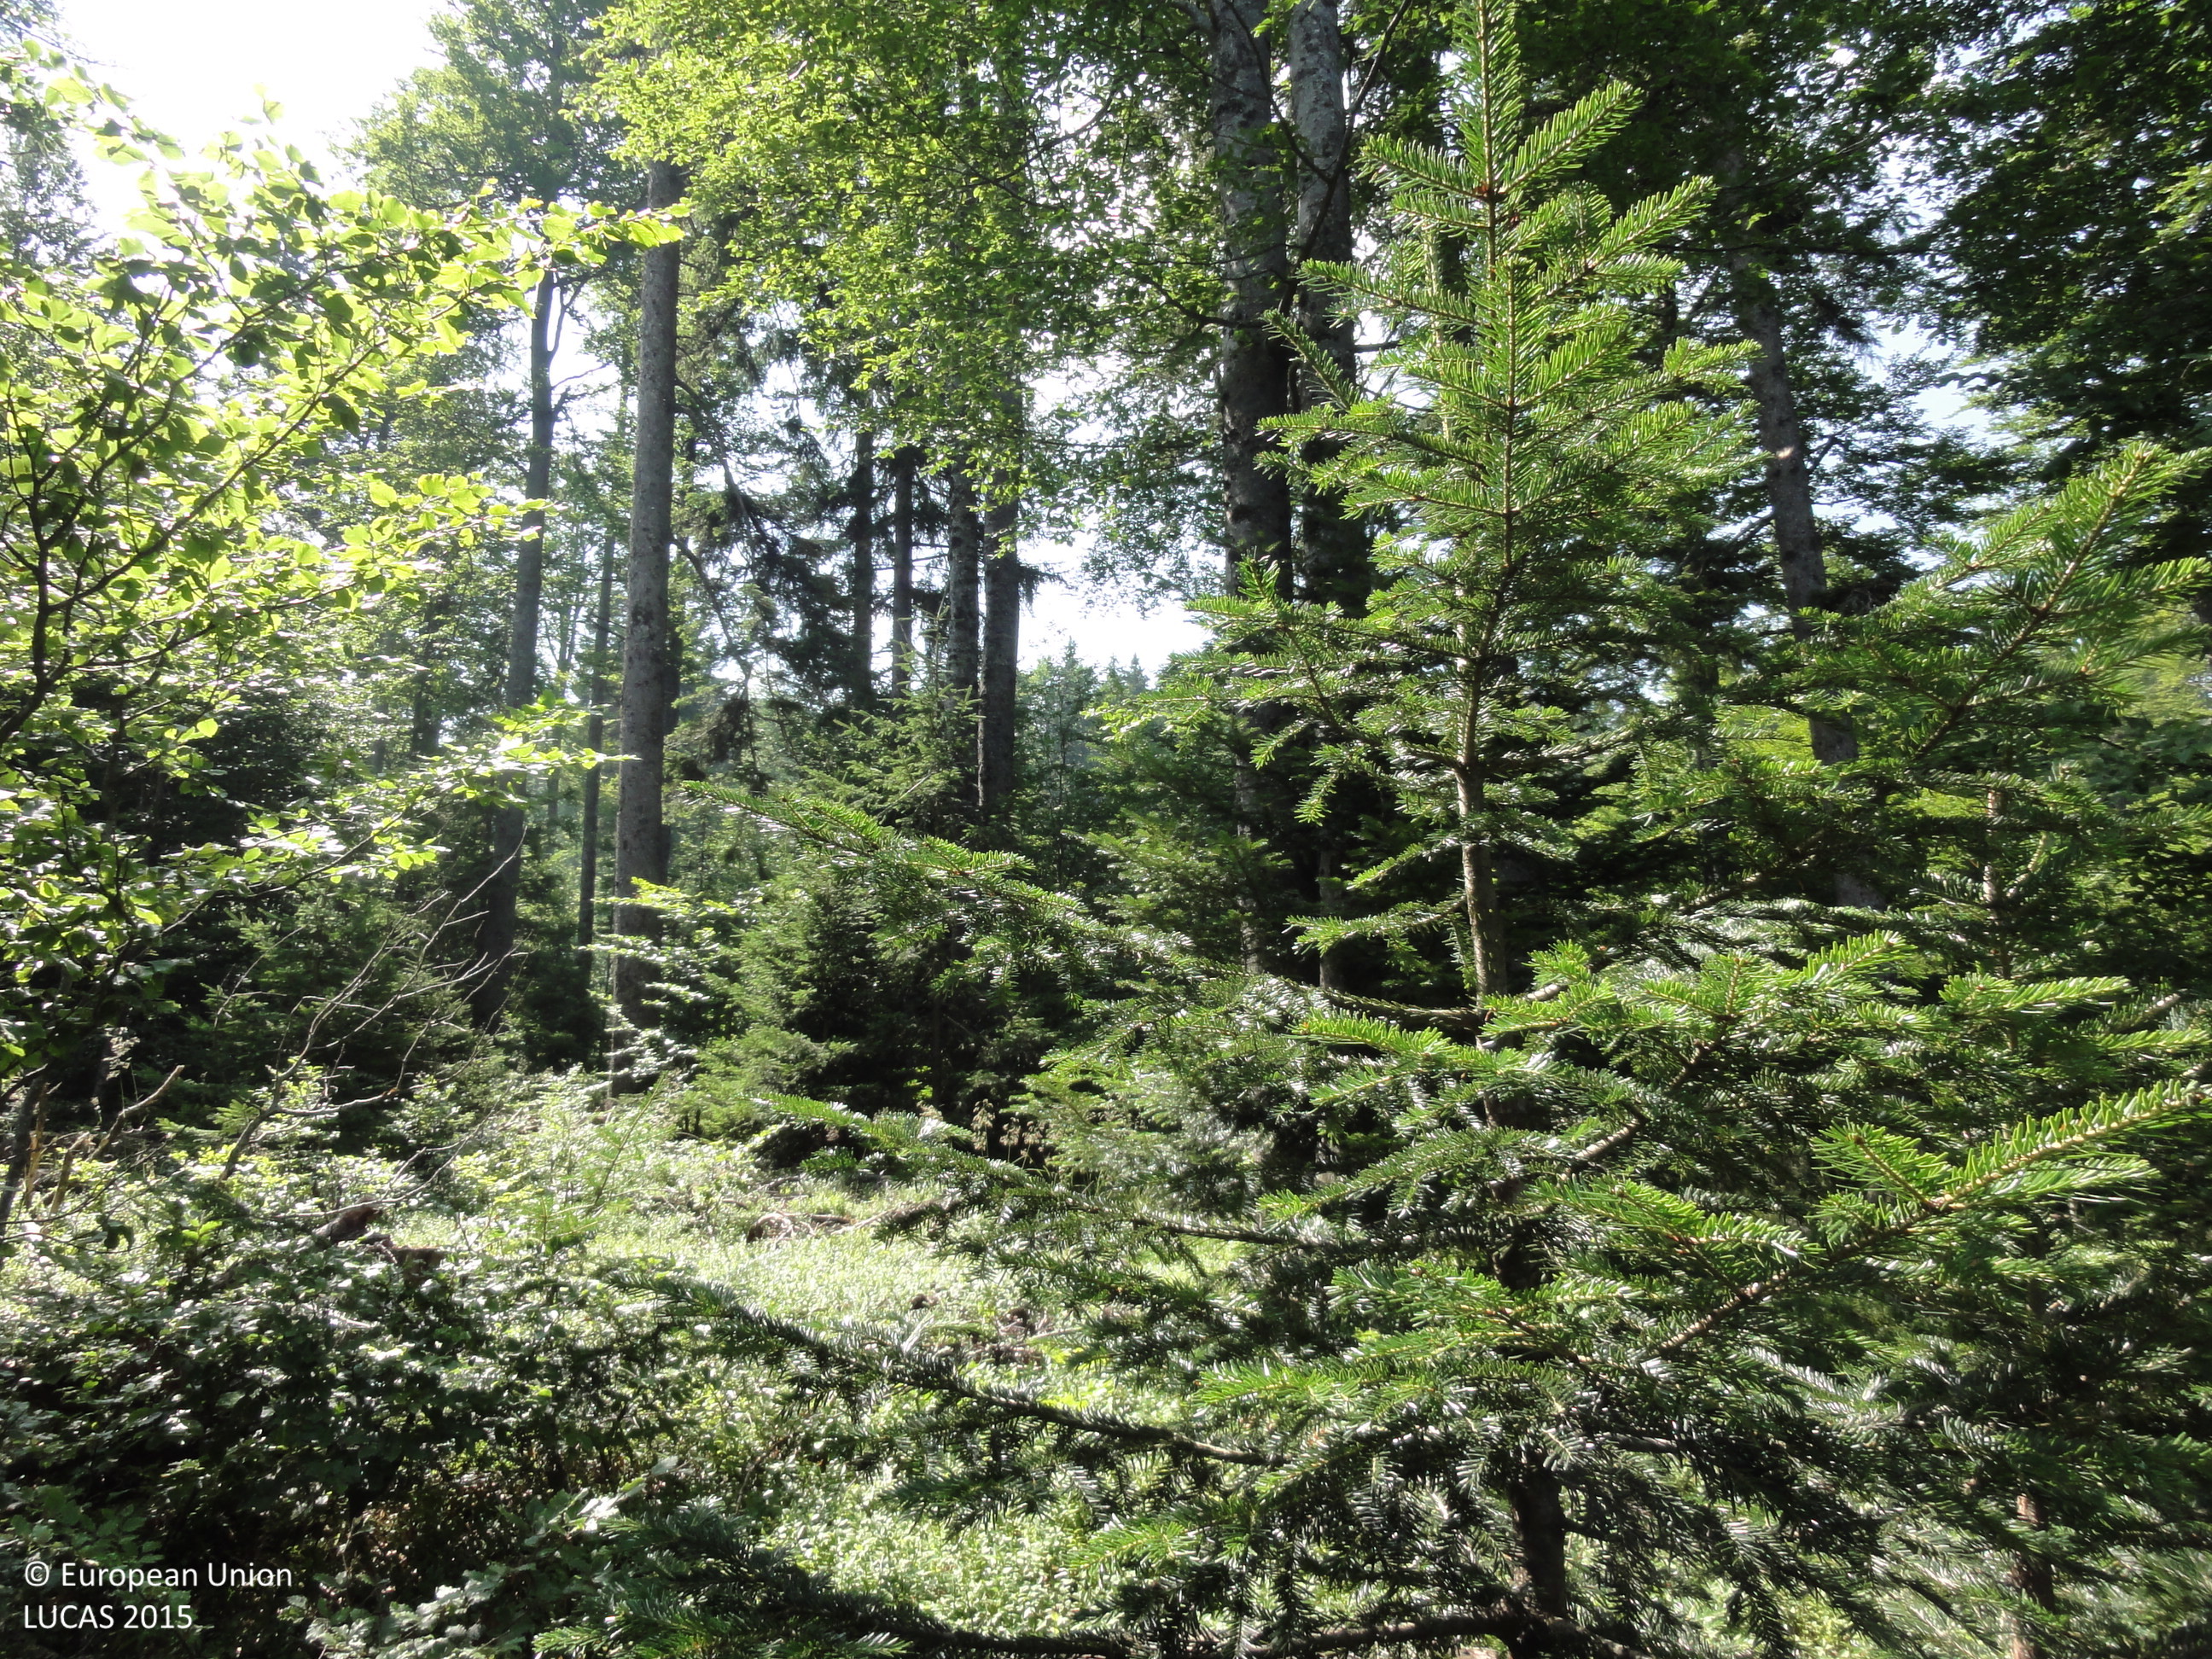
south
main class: Woodland
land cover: Other mixed woodland
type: mountainous beech forest
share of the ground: > 75 %
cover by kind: coniferous forest trees 65 %, broadleaved forest trees 25 %, shrubs 5 %, herbaceous plants 5 %
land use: Forestry
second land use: Amenities, museums, leisure
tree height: > 5 m
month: July
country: SI
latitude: 46.4993
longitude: 15.4843
